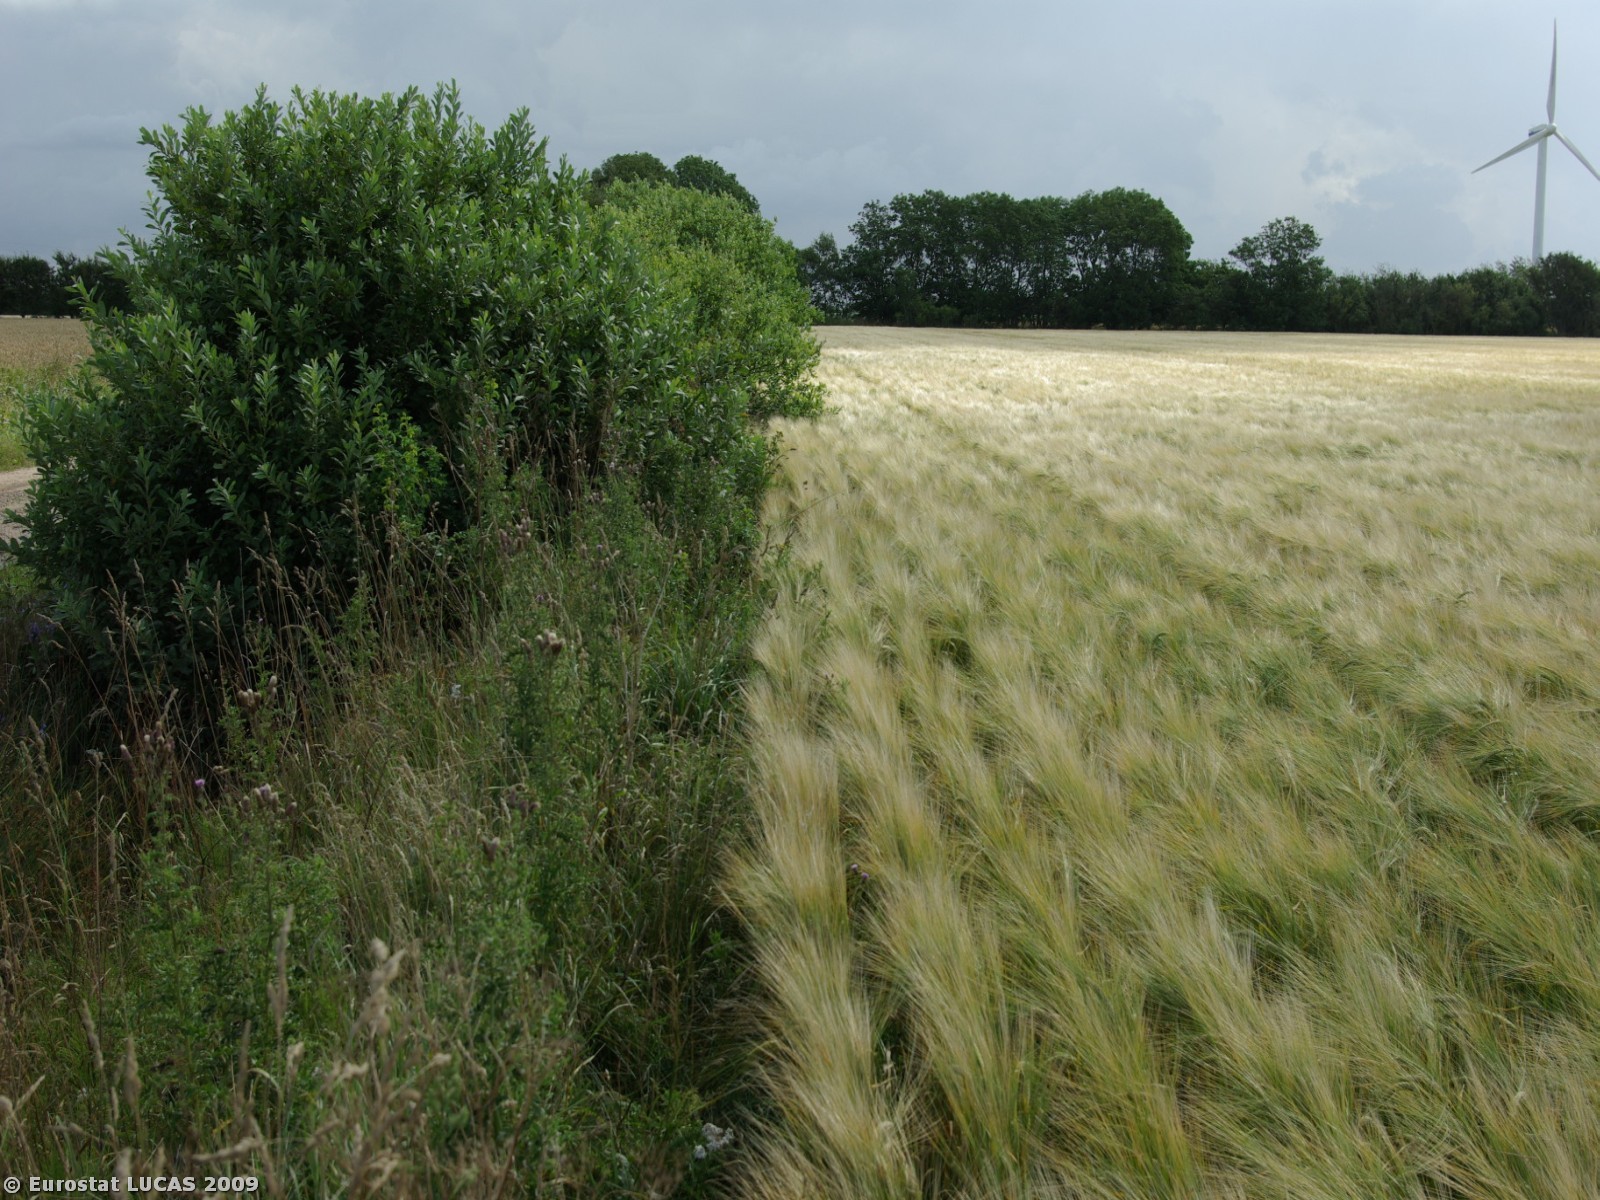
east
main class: Cropland
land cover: Barley
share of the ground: > 75 %
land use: Agriculture (excluding fallow land and kitchen gardens)
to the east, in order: Barley; Broadleaved woodland; Oats
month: July
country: DK
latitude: 54.9957
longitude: 8.7973
